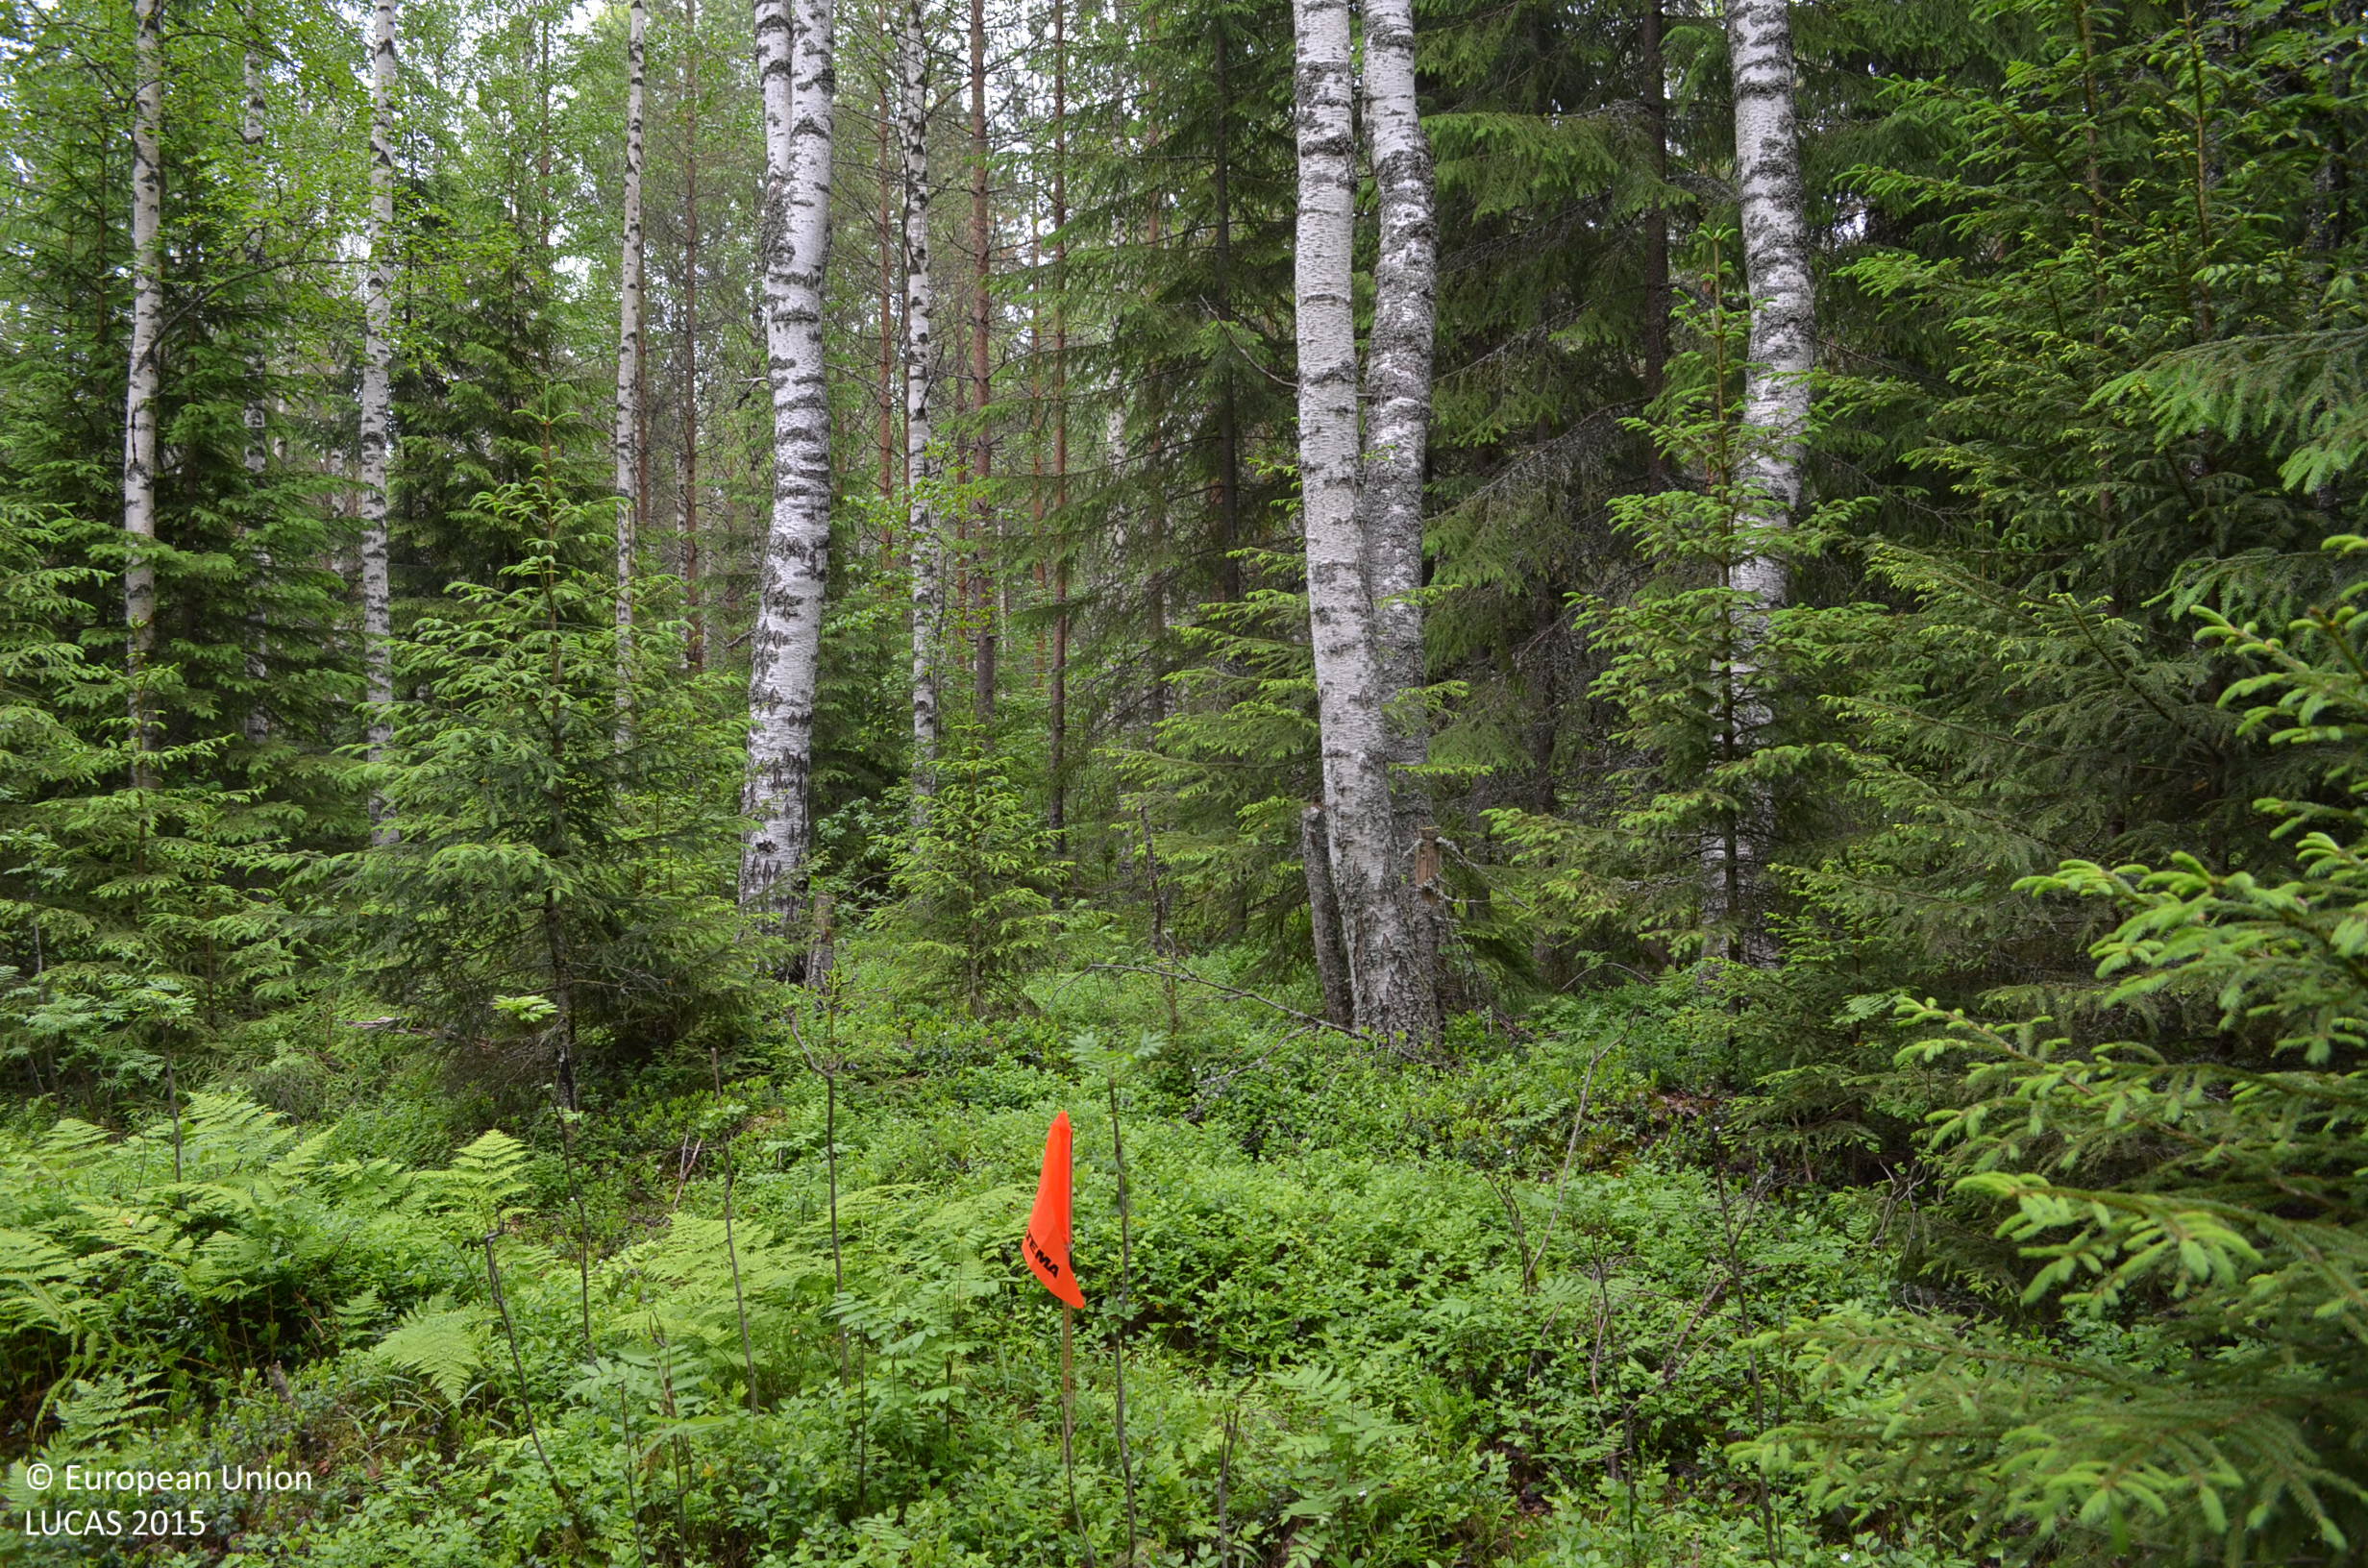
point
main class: Woodland
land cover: Other mixed woodland
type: boreal forest
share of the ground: > 75 %
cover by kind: broadleaved forest trees 45 %, coniferous forest trees 35 %, shrubs 20 %
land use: Forestry
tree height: > 5 m
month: June
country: FI
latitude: 61.7104
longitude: 23.0647
